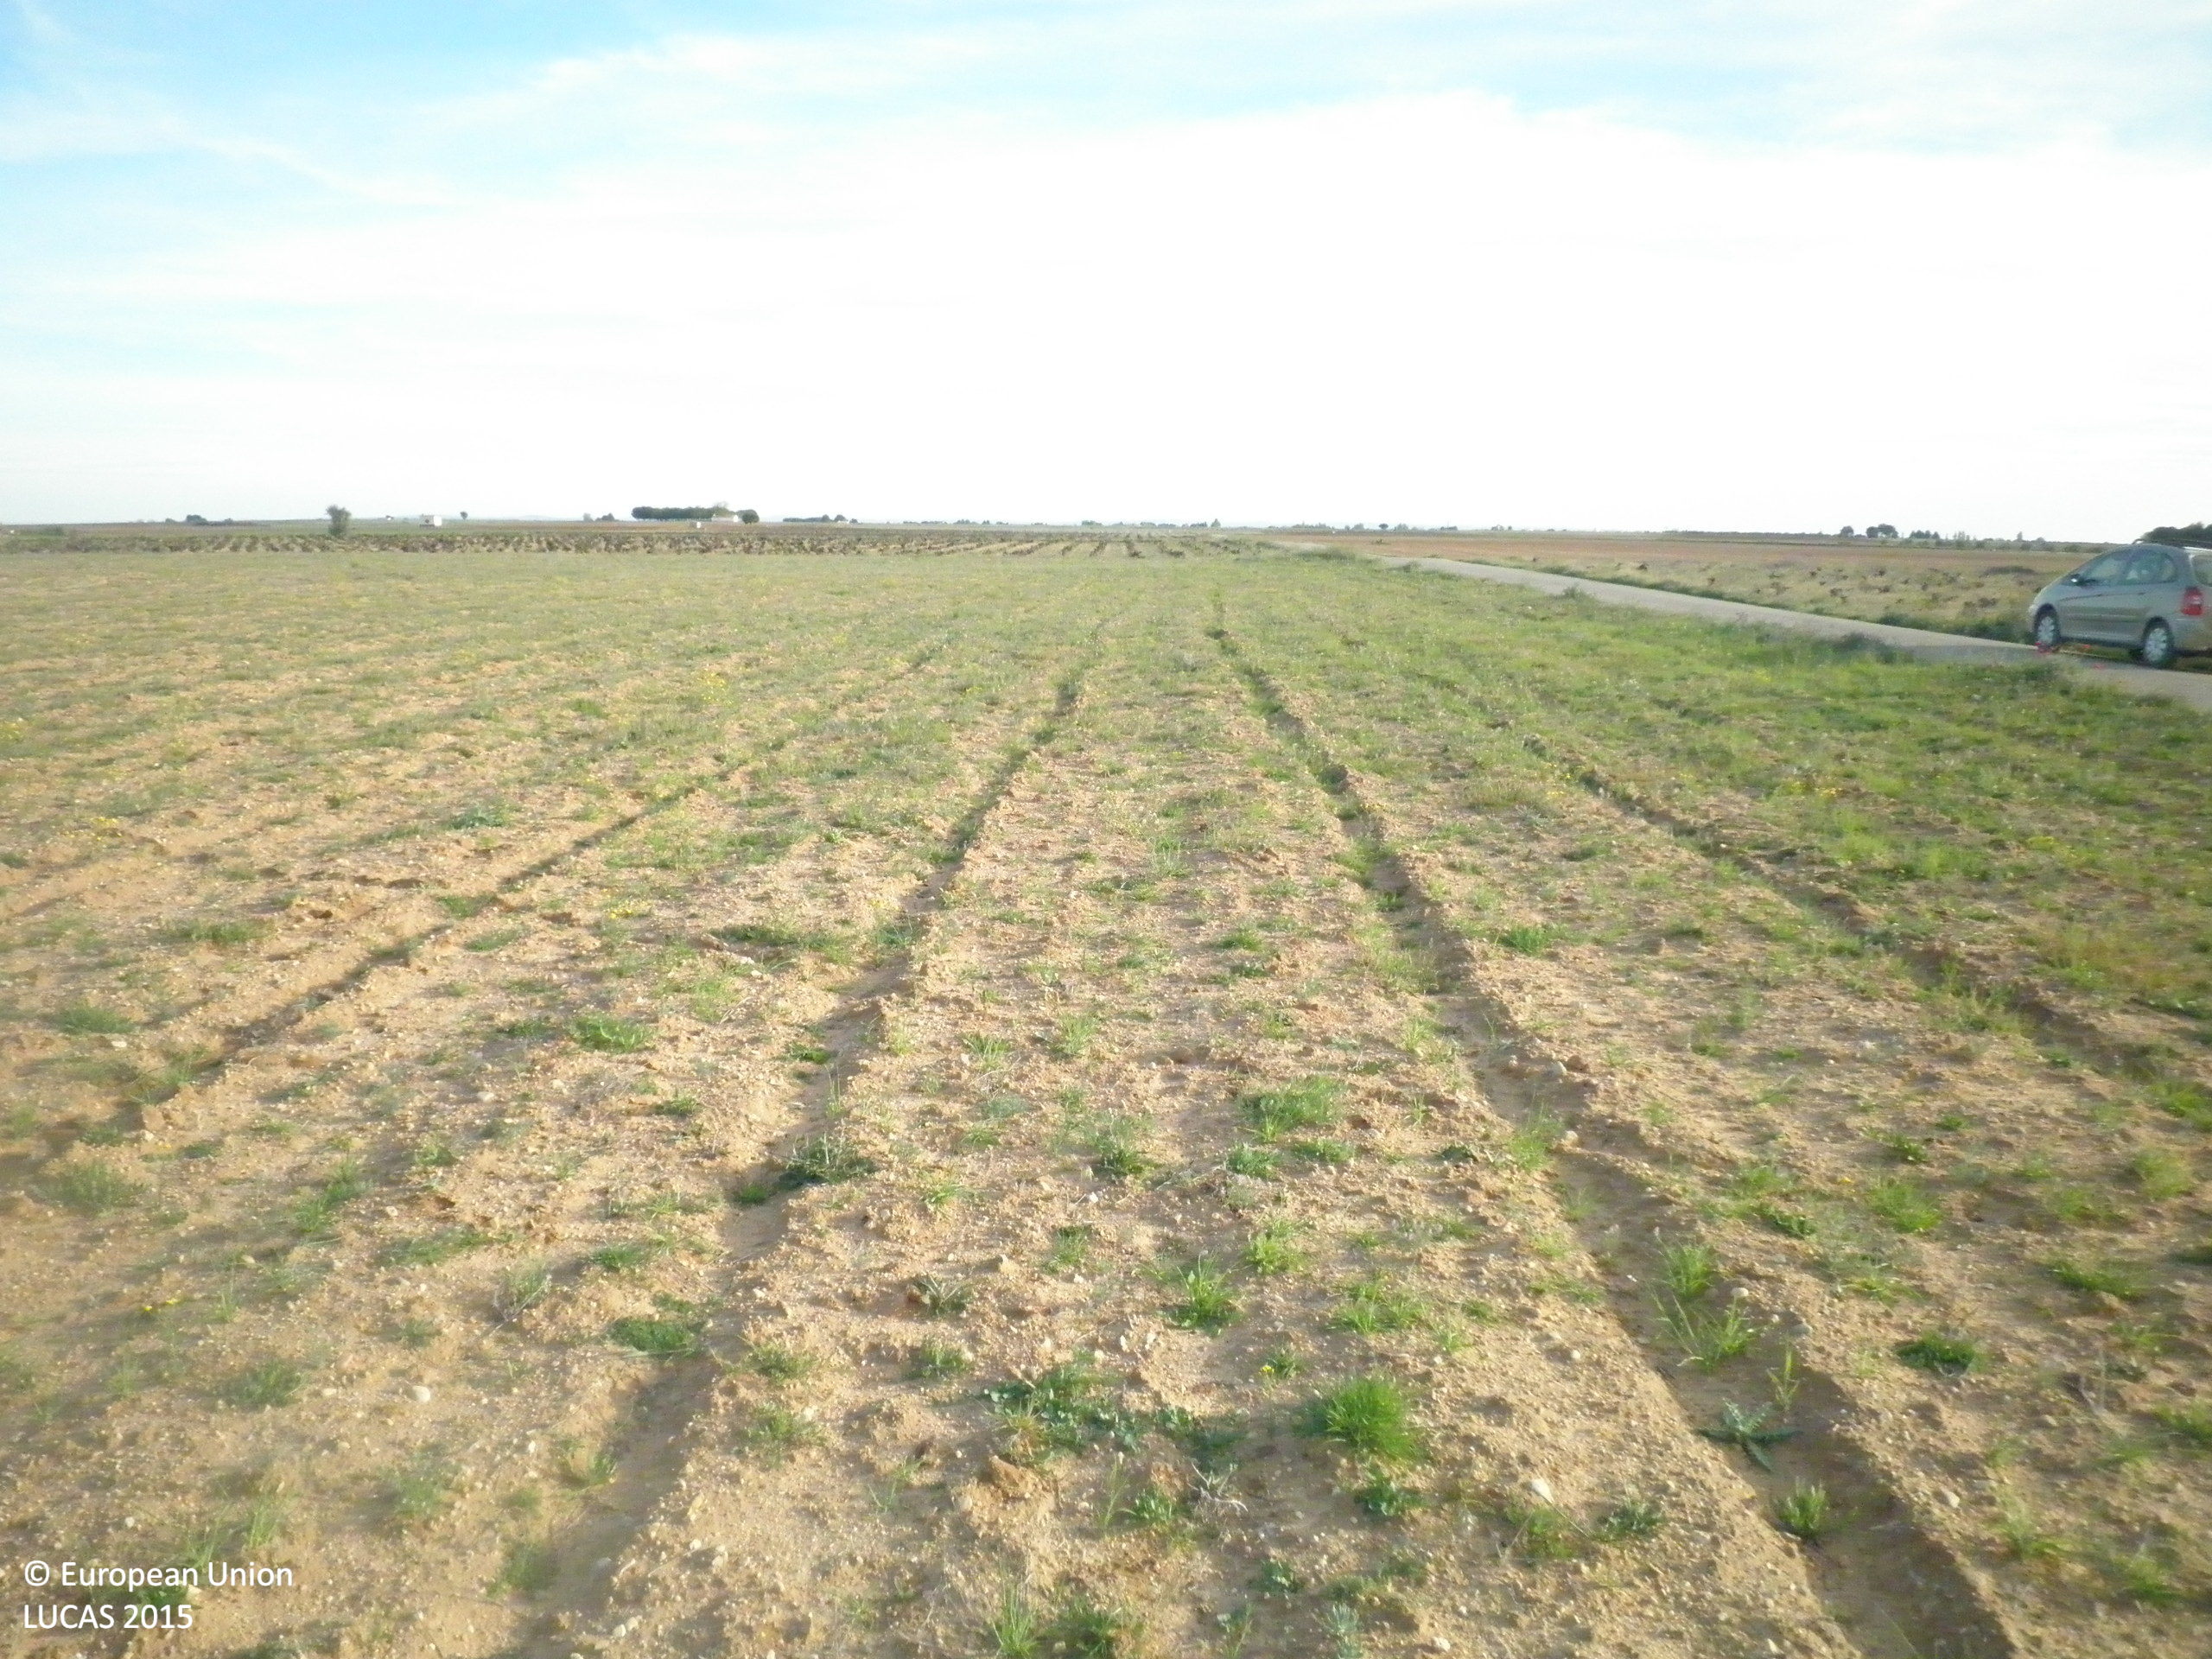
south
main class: Grassland
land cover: Spontaneously vegetated surfaces
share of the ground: 10 - 25 %
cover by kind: unconsolidated bare surface 75 %, herbaceous plants 25 %
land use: Fallow land
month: April
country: ES
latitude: 39.3385
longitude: -2.7633
